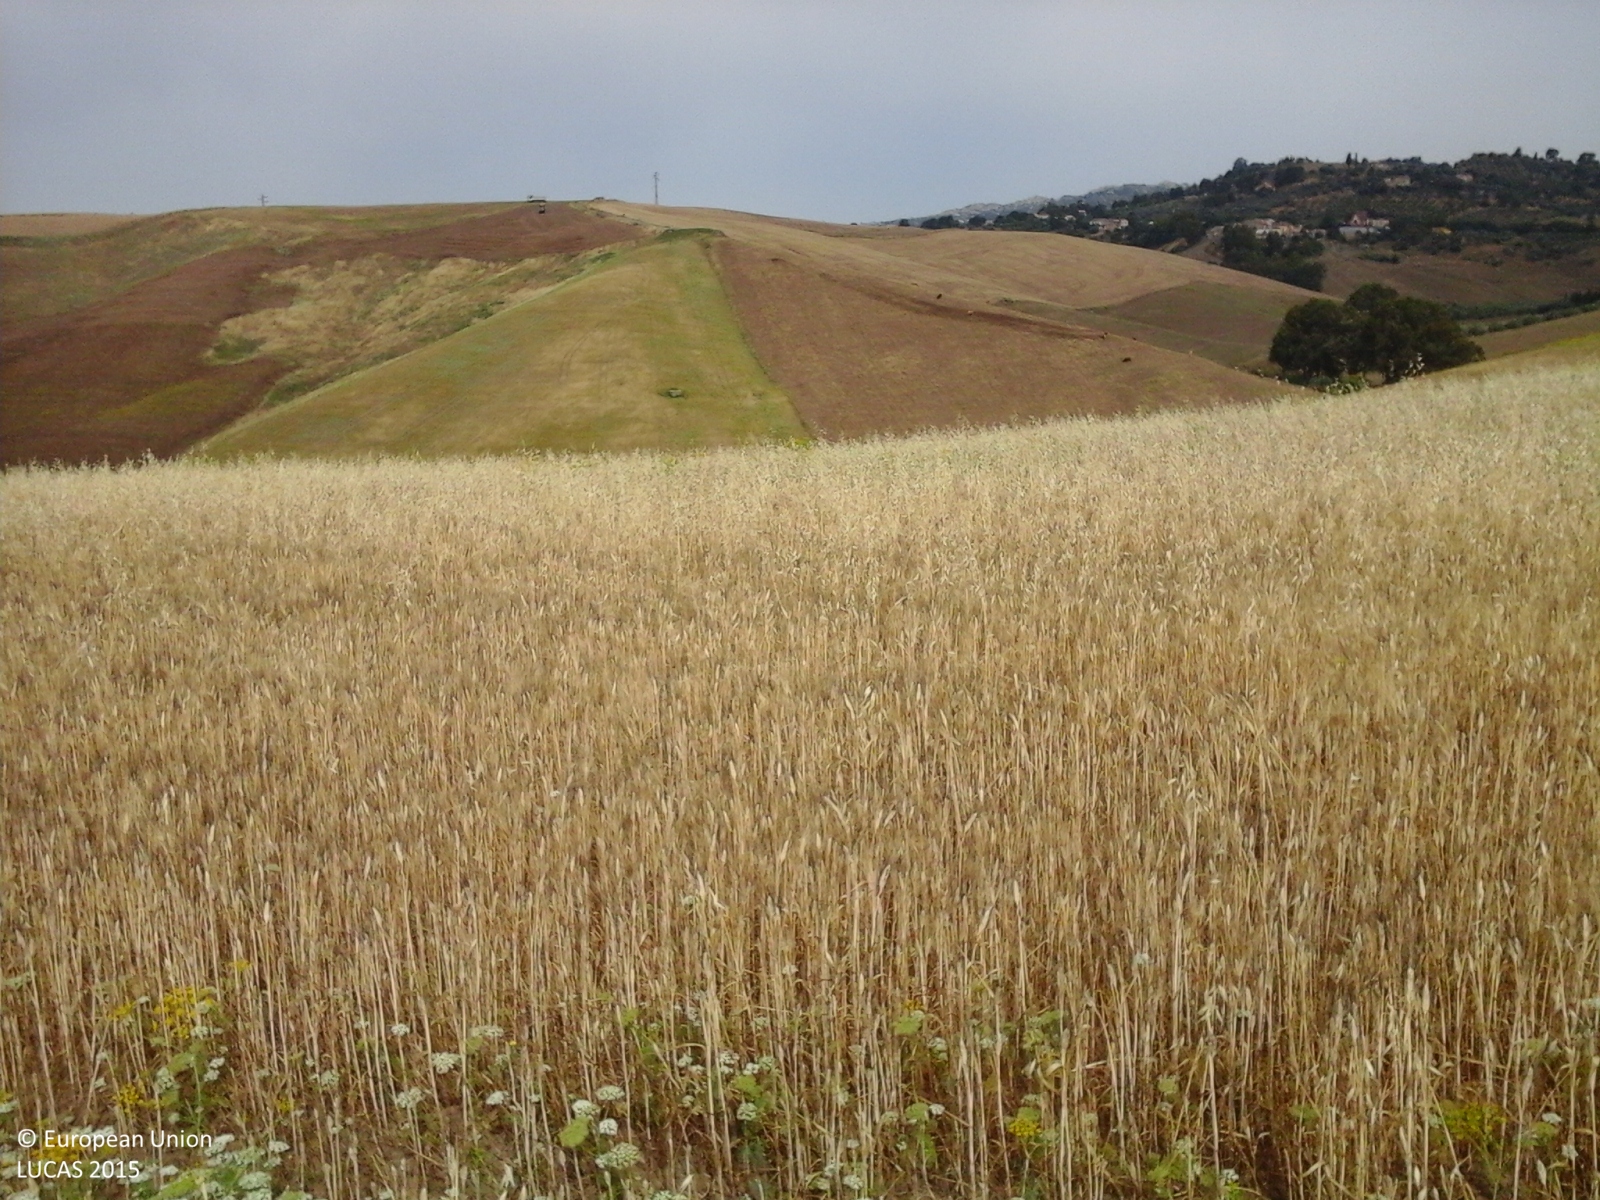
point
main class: Cropland
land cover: Durum wheat
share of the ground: > 75 %
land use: Agriculture (excluding fallow land and kitchen gardens)
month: June
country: IT
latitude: 37.4441
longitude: 14.0274
